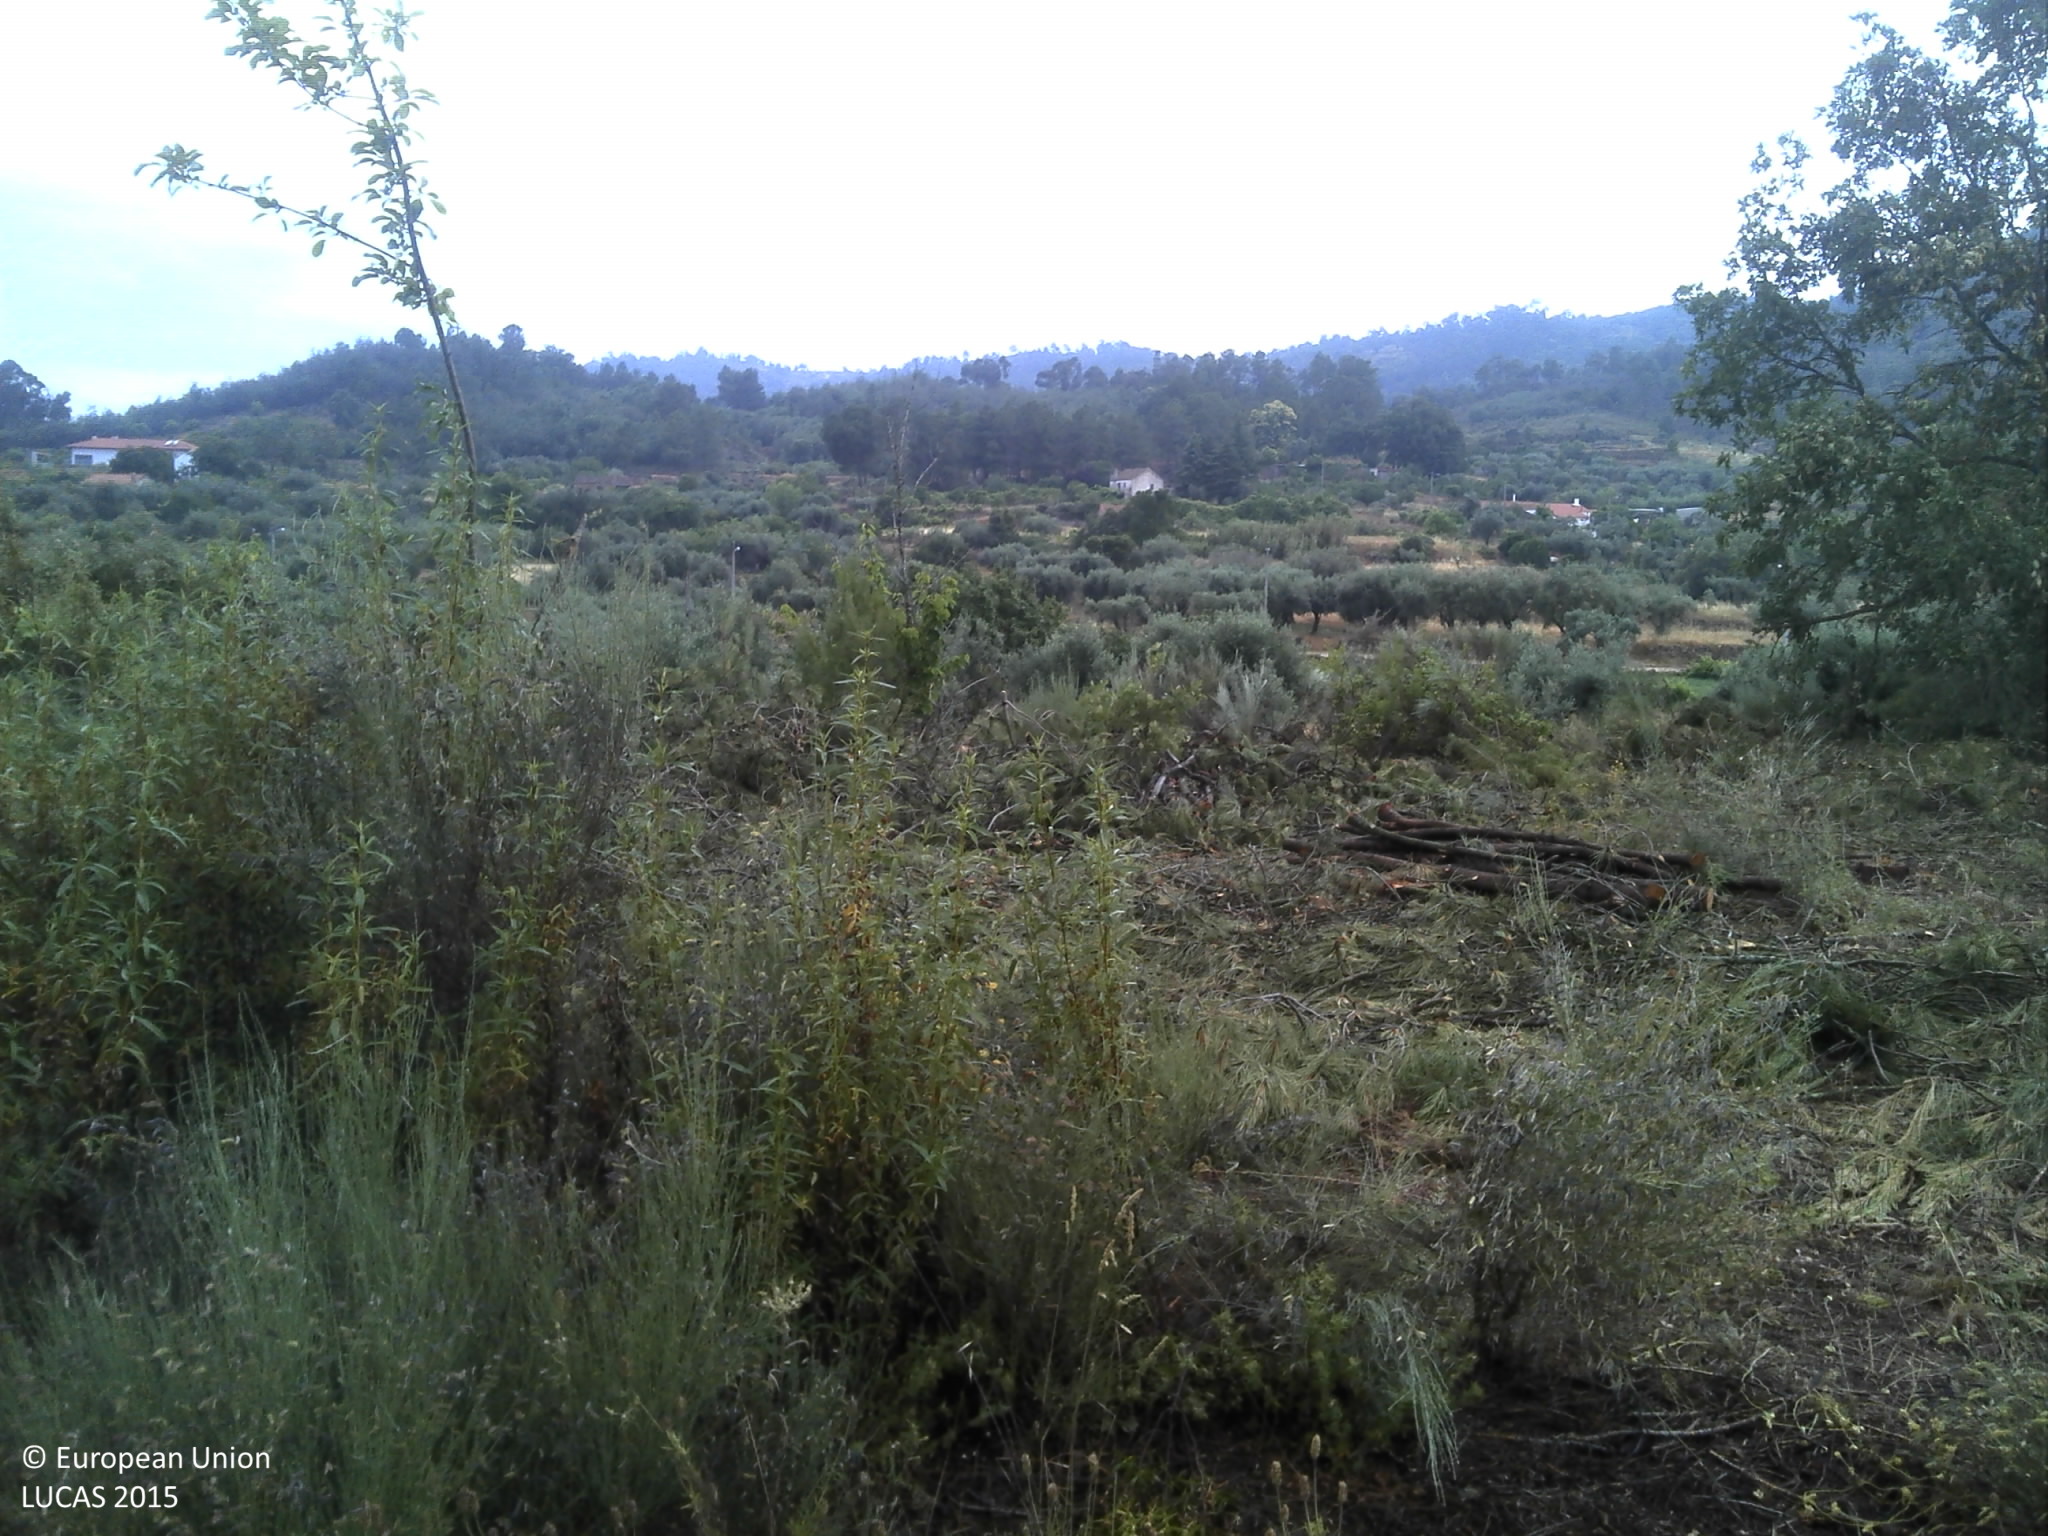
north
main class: Shrubland
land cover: Shrubland with sparse tree cover
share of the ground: 25 - 50 %
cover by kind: unconsolidated bare surface 45 %, shrubs 40 %, herbaceous plants 10 %, broadleaved forest trees 5 %
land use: Forestry
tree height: < 5 m
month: June
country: PT
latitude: 40.2062
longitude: -7.4336
